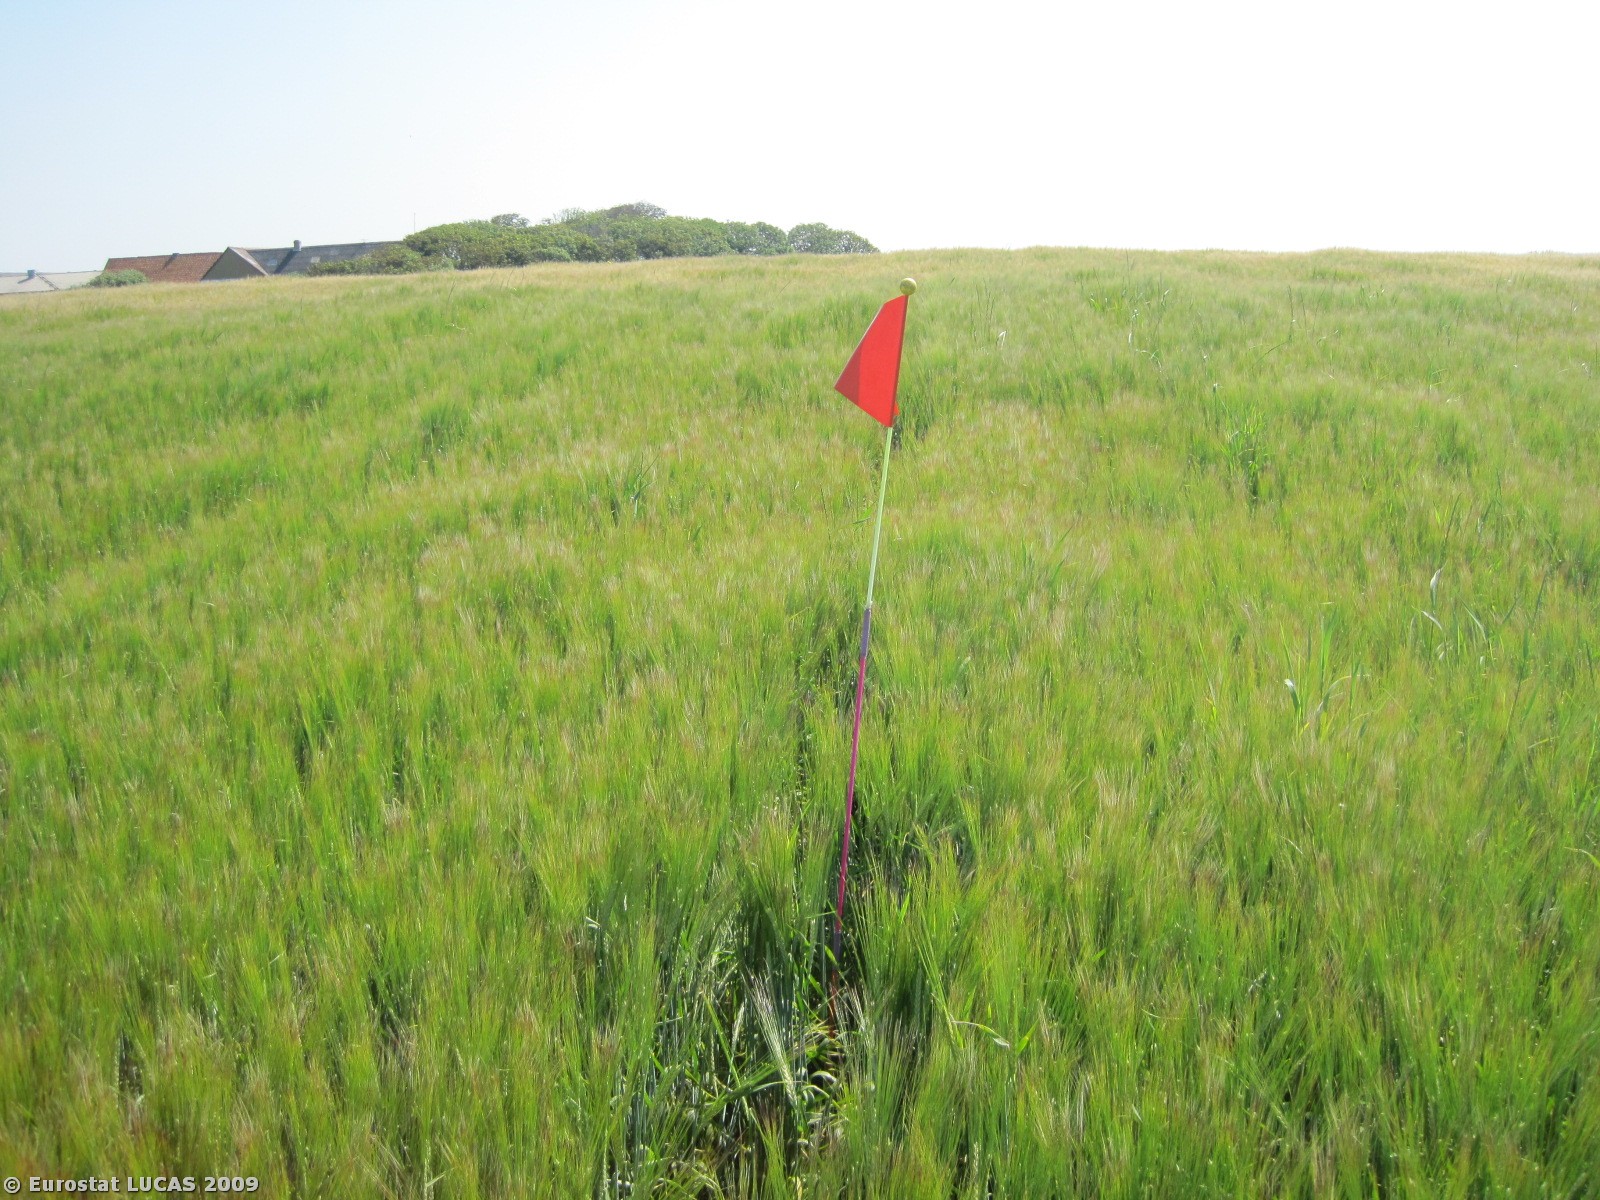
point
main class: Cropland
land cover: Barley
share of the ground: > 75 %
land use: Agriculture (excluding fallow land and kitchen gardens)
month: July
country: DK
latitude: 56.4804
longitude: 8.1674
